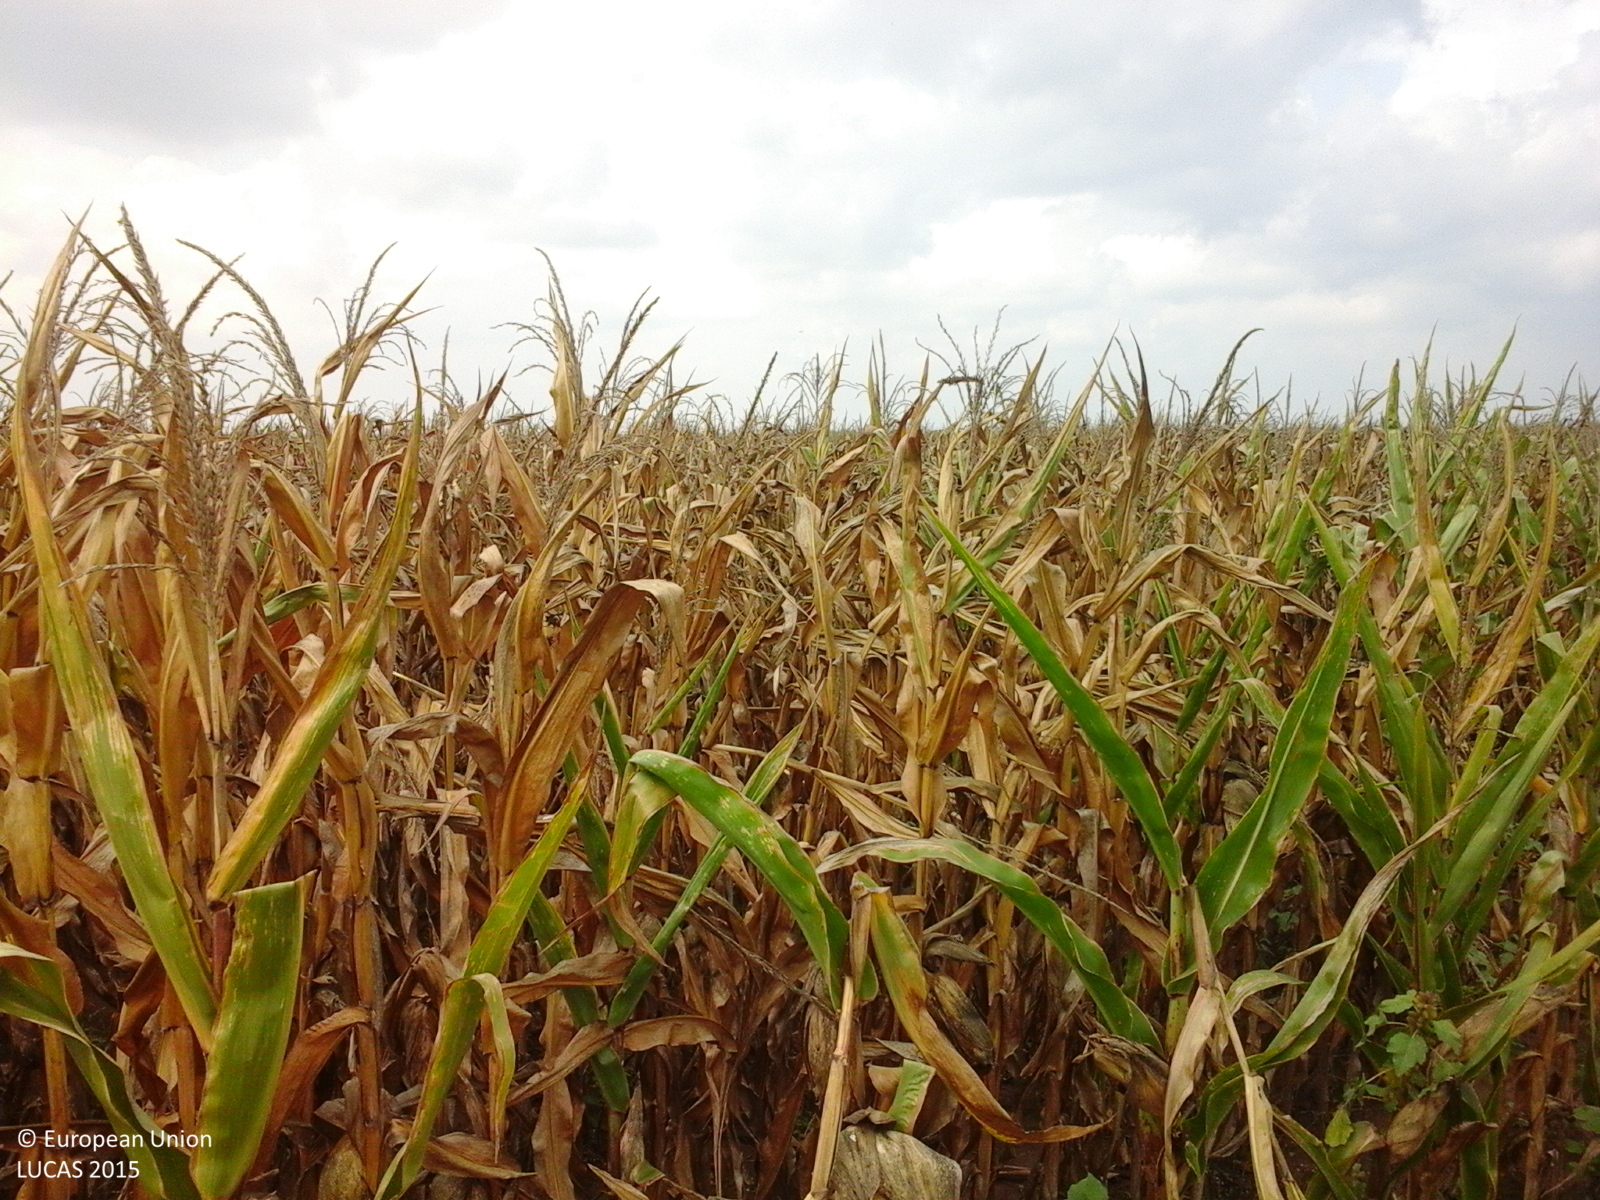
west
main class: Cropland
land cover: Maize
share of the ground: > 75 %
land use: Agriculture (excluding fallow land and kitchen gardens)
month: September
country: RO
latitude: 46.7317
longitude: 21.8072
